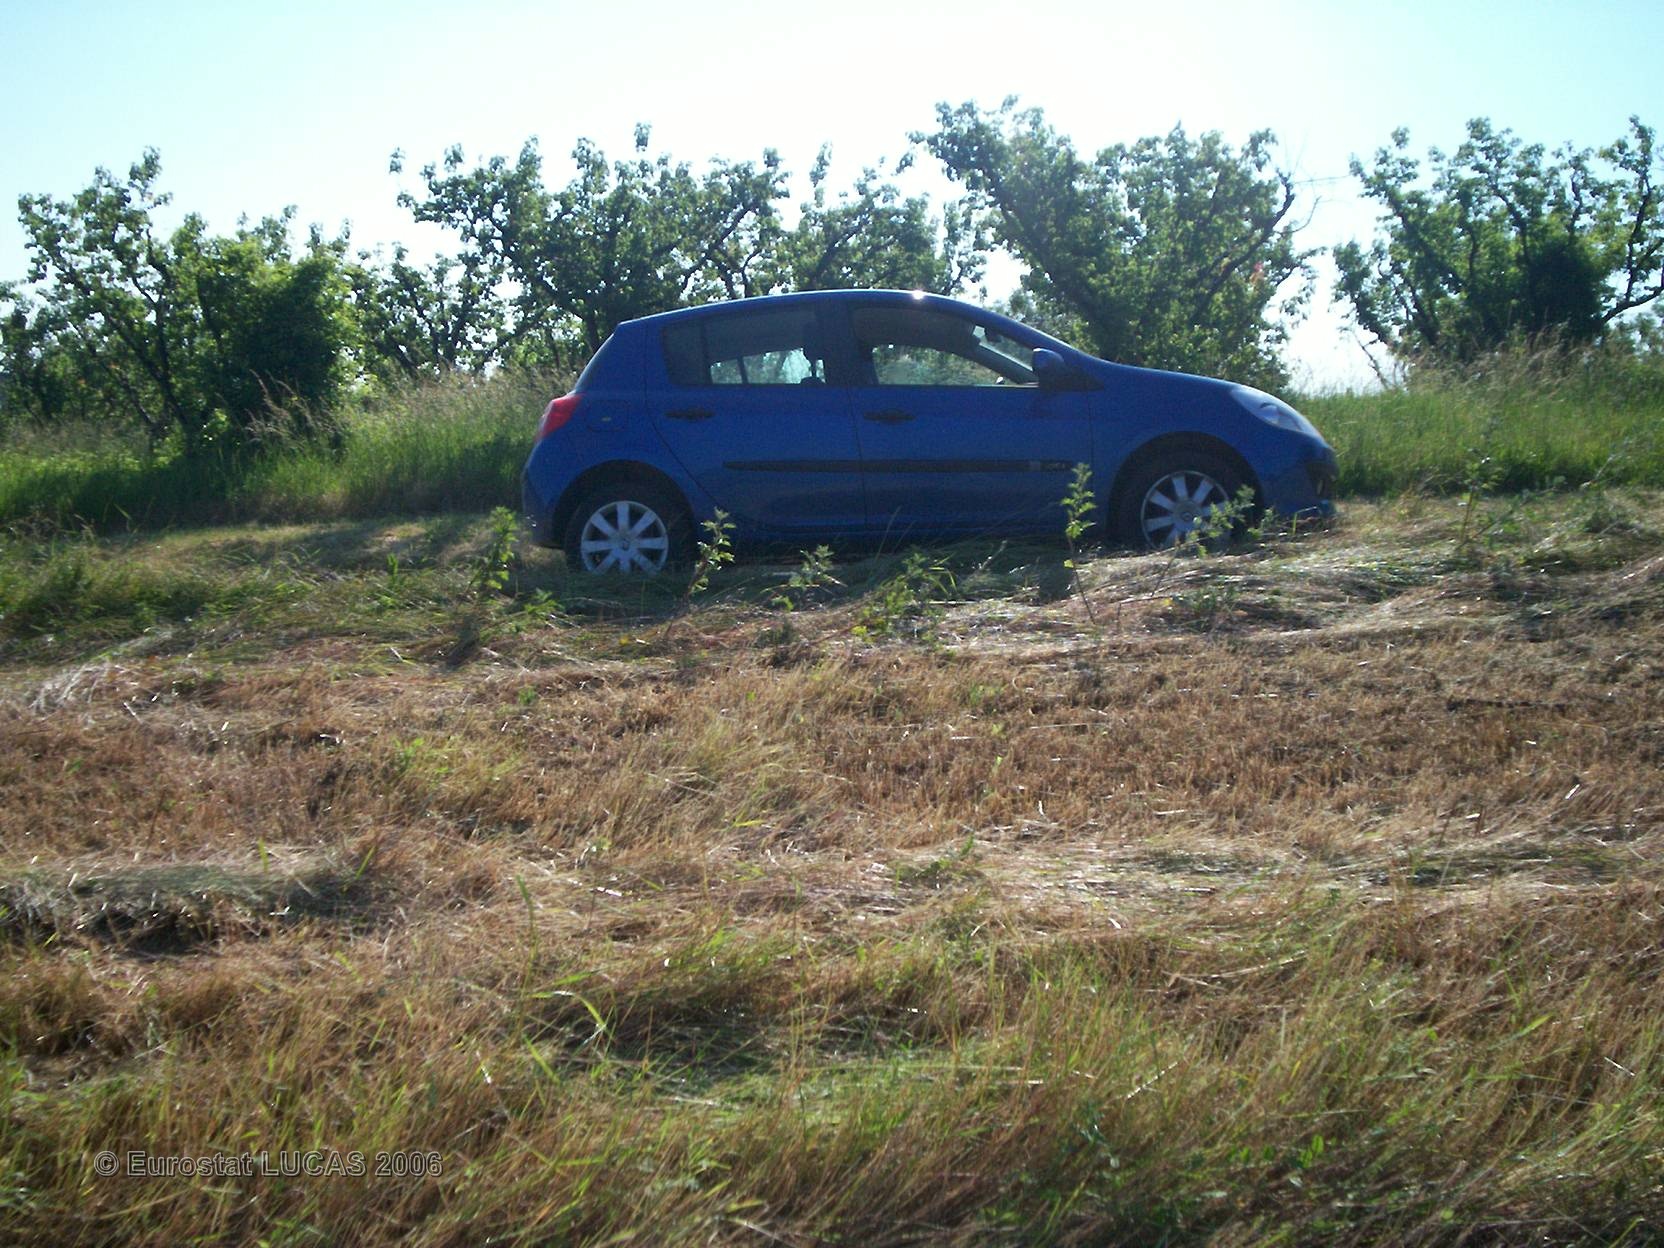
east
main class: Grassland
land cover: Grassland without tree/shrub cover
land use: Agriculture (excluding fallow land and kitchen gardens)
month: June
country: FR
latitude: 45.1275
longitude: 4.8814
